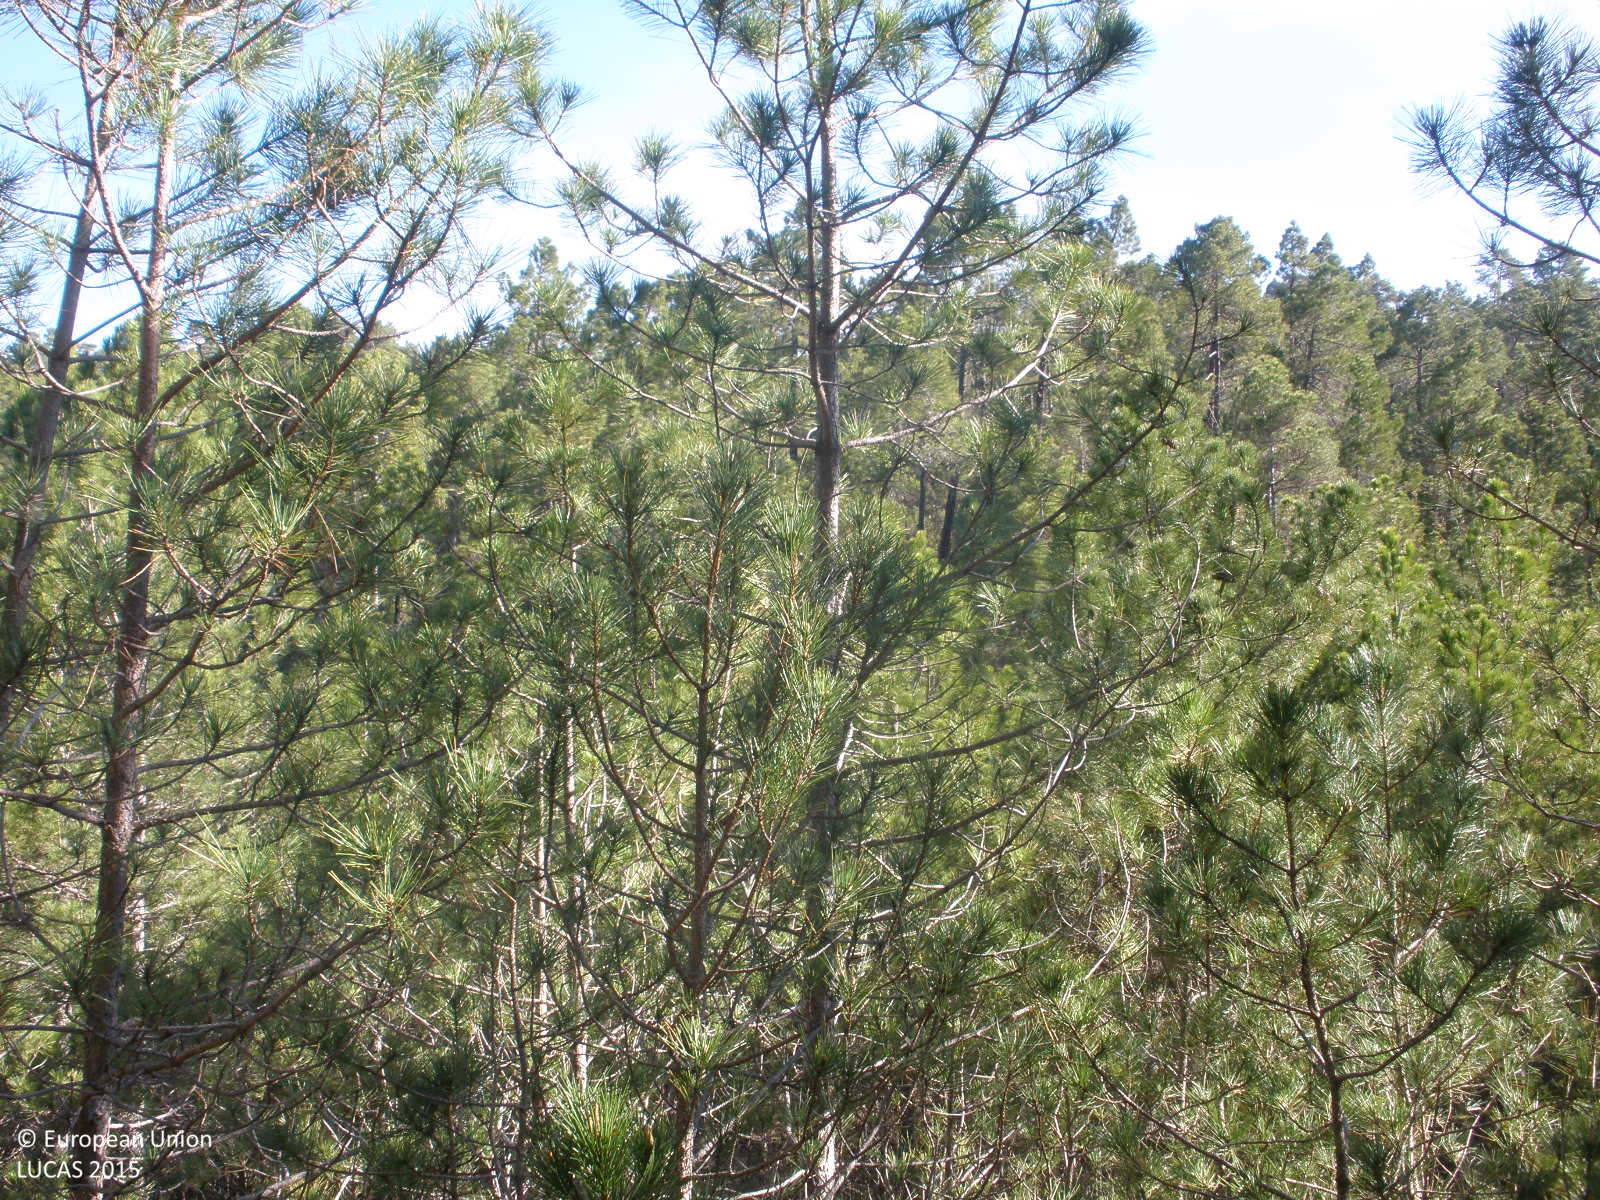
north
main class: Woodland
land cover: Pine dominated coniferous woodland
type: coniferous forest of the mediterranean region
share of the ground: > 75 %
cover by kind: coniferous forest trees 75 %, shrubs 15 %, herbaceous plants 10 %
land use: Forestry
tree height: > 5 m
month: April
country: ES
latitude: 40.2900
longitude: -0.7948
